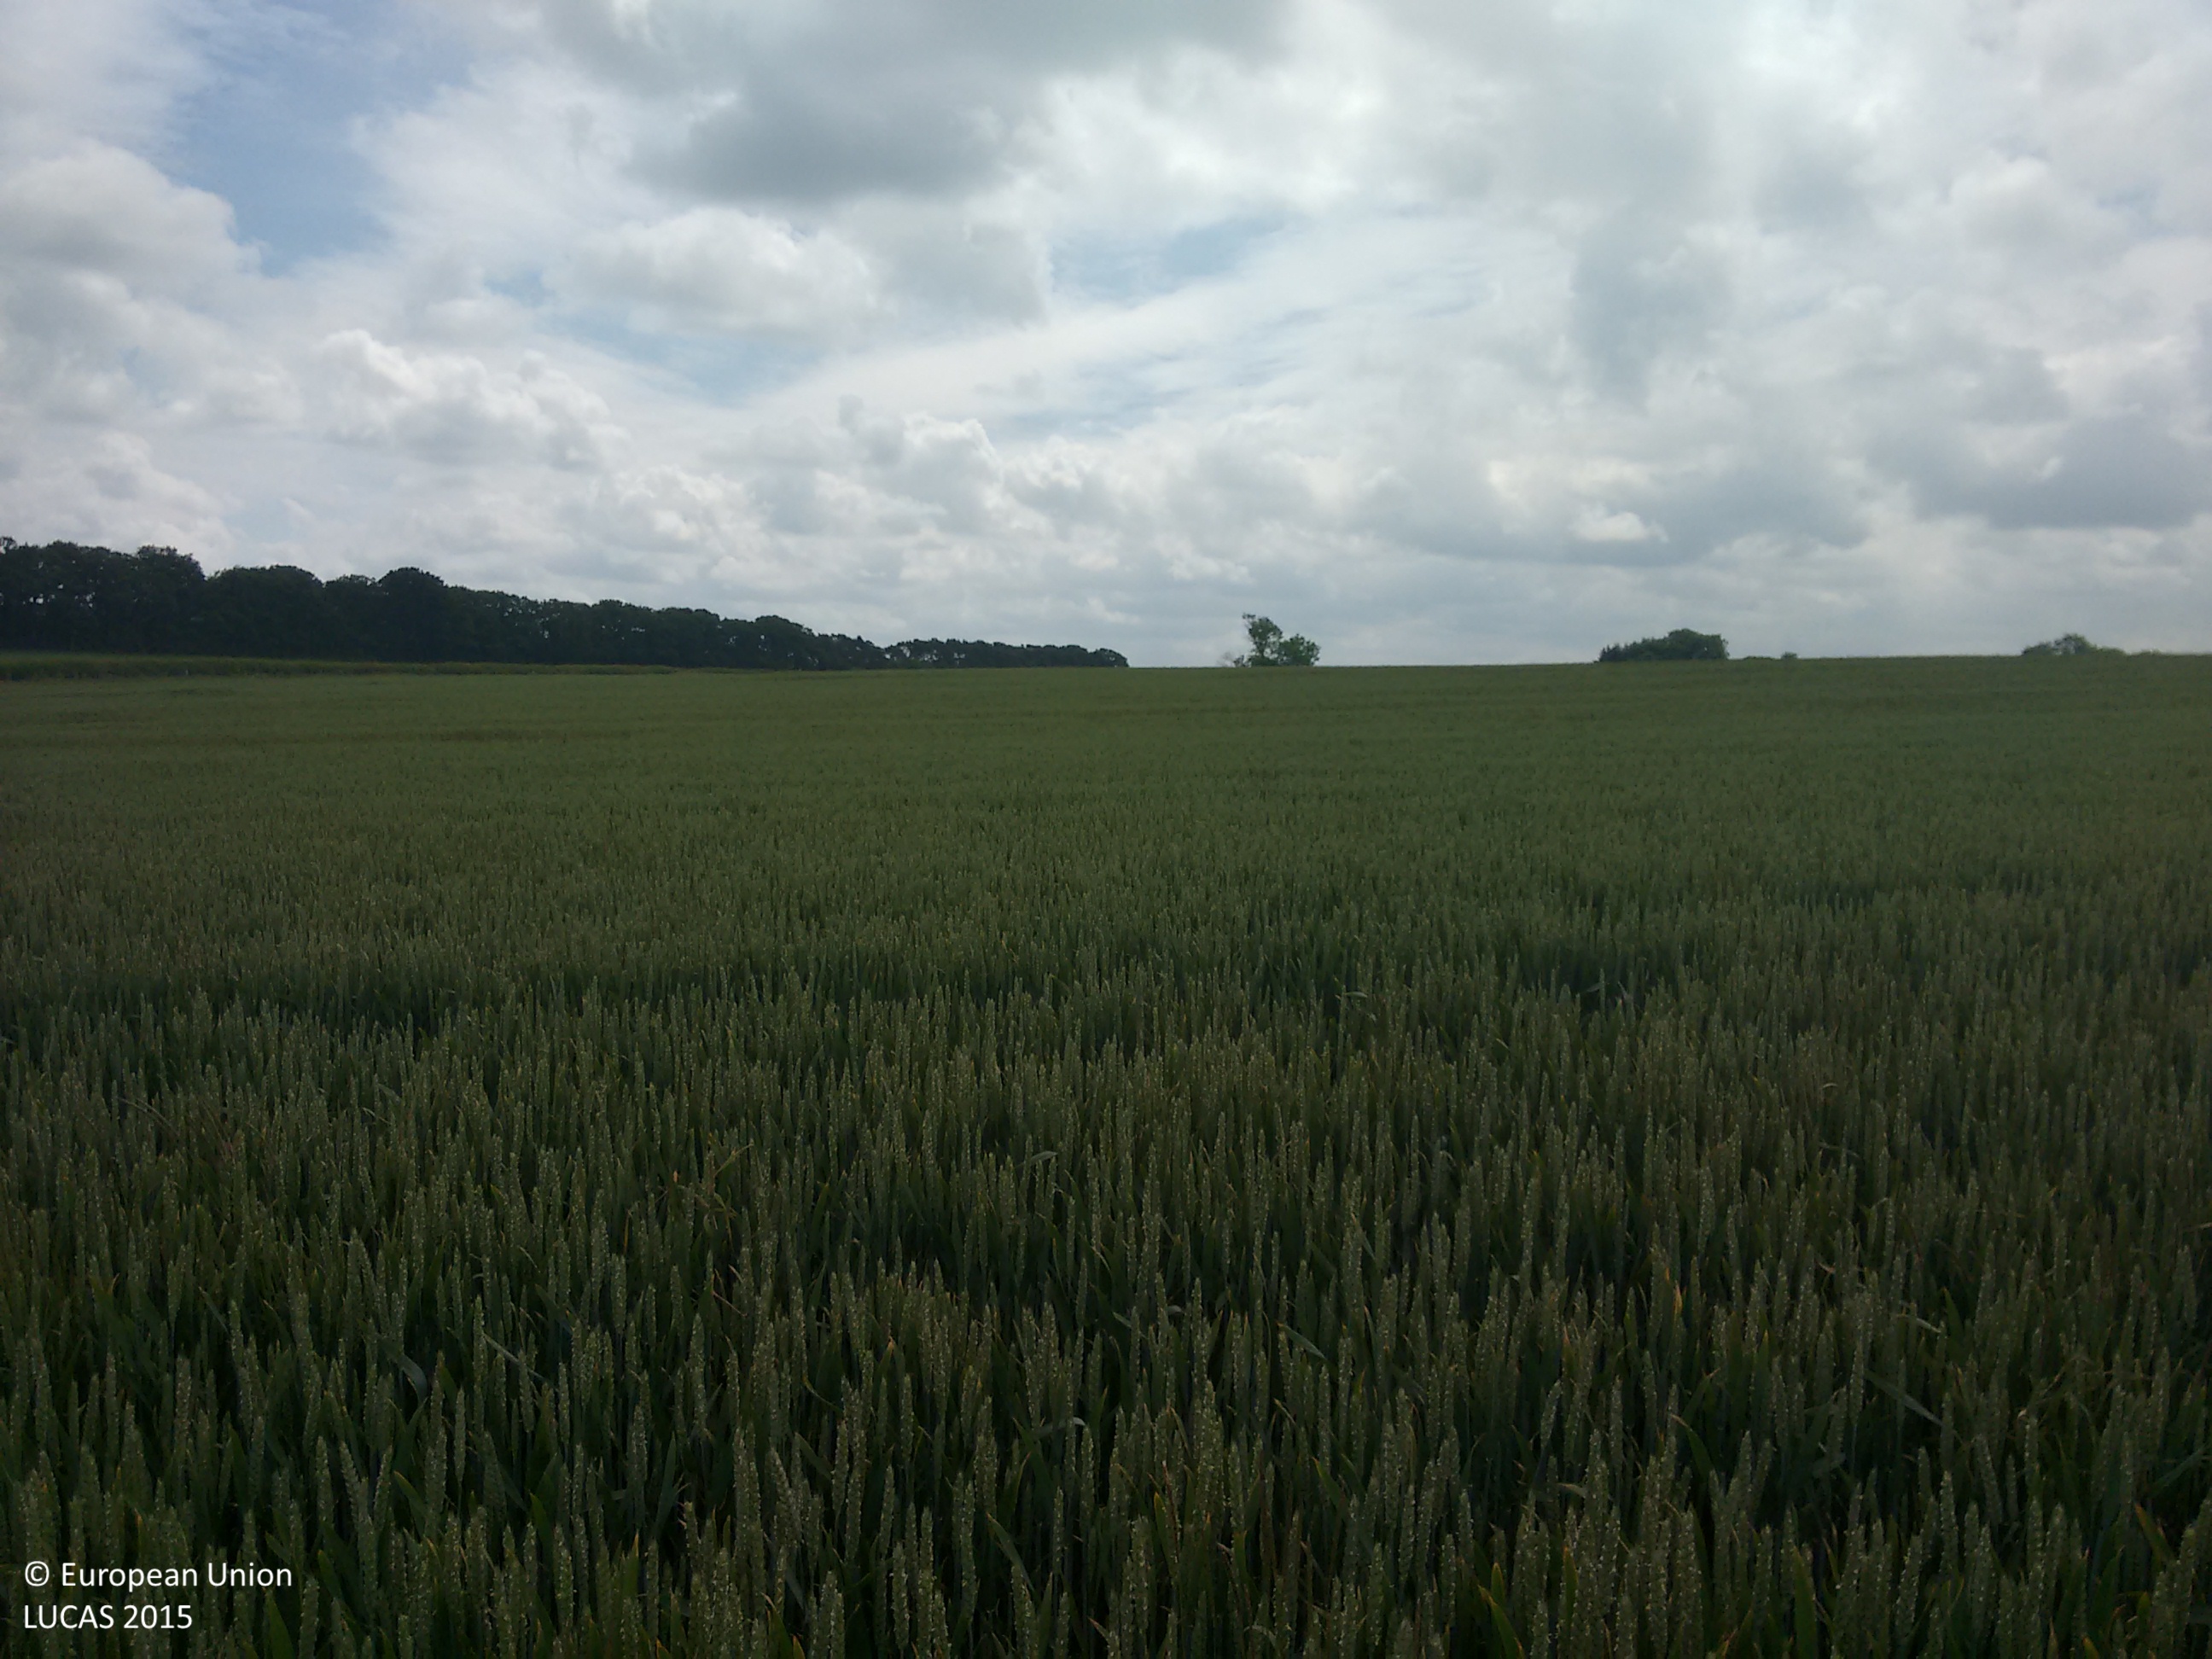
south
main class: Cropland
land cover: Common wheat
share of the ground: > 75 %
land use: Agriculture (excluding fallow land and kitchen gardens)
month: June
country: GB
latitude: 54.2343
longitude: -0.8876
